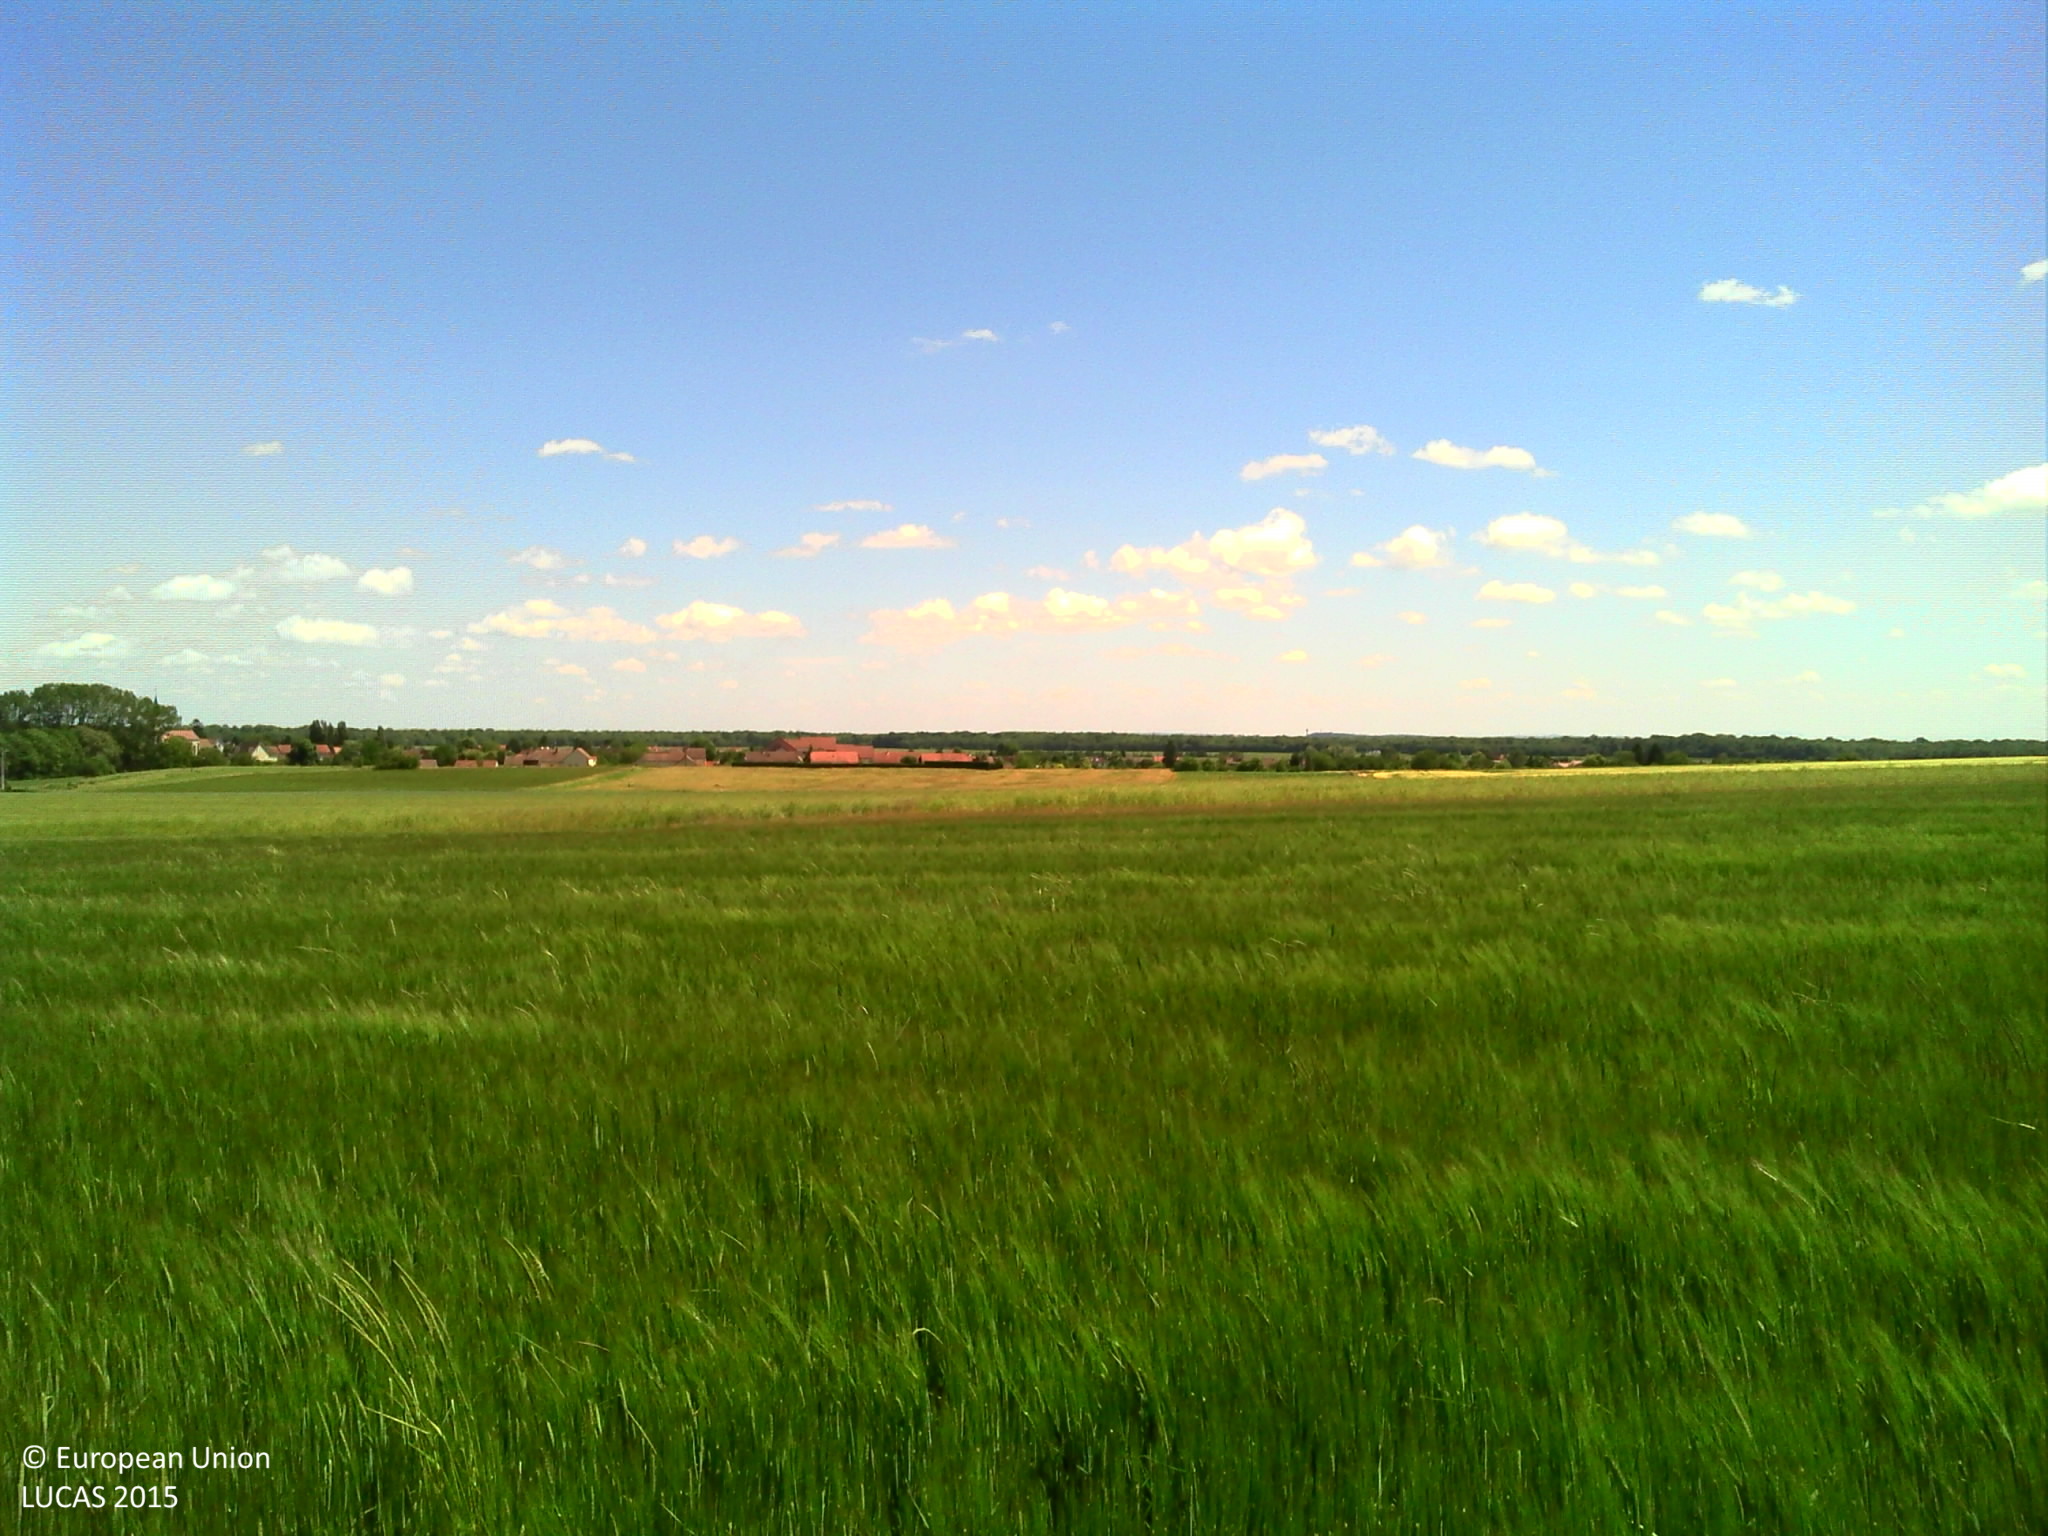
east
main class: Cropland
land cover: Barley
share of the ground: > 75 %
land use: Agriculture (excluding fallow land and kitchen gardens)
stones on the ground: < 10 %
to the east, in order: Barley; Grassland without tree/shrub cover; Tracks; Rape and turnip rape; Grass margins; Tracks; Rape and turnip rape
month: June
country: FR
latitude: 47.2120
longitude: 5.0759
